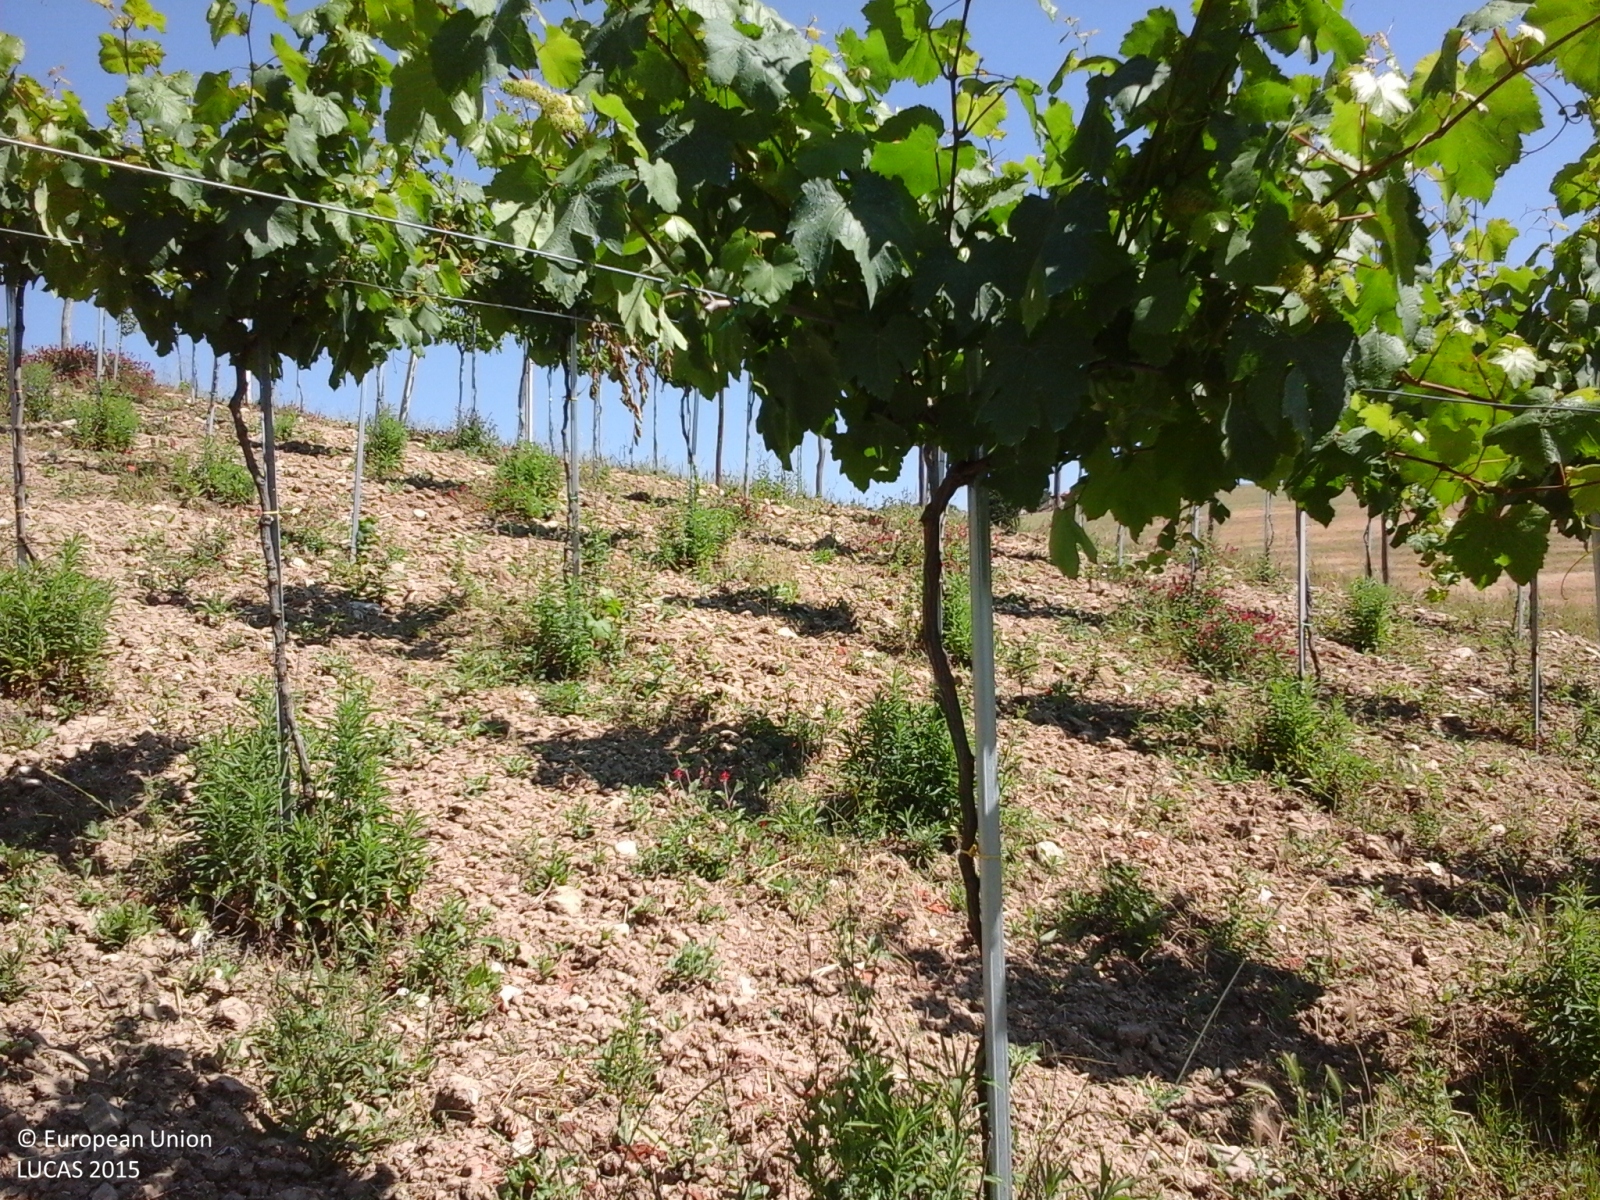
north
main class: Cropland
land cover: Vineyards
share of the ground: > 75 %
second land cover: Other bare soil
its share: > 75 %
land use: Agriculture (excluding fallow land and kitchen gardens)
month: June
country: IT
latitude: 41.2089
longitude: 15.0026
